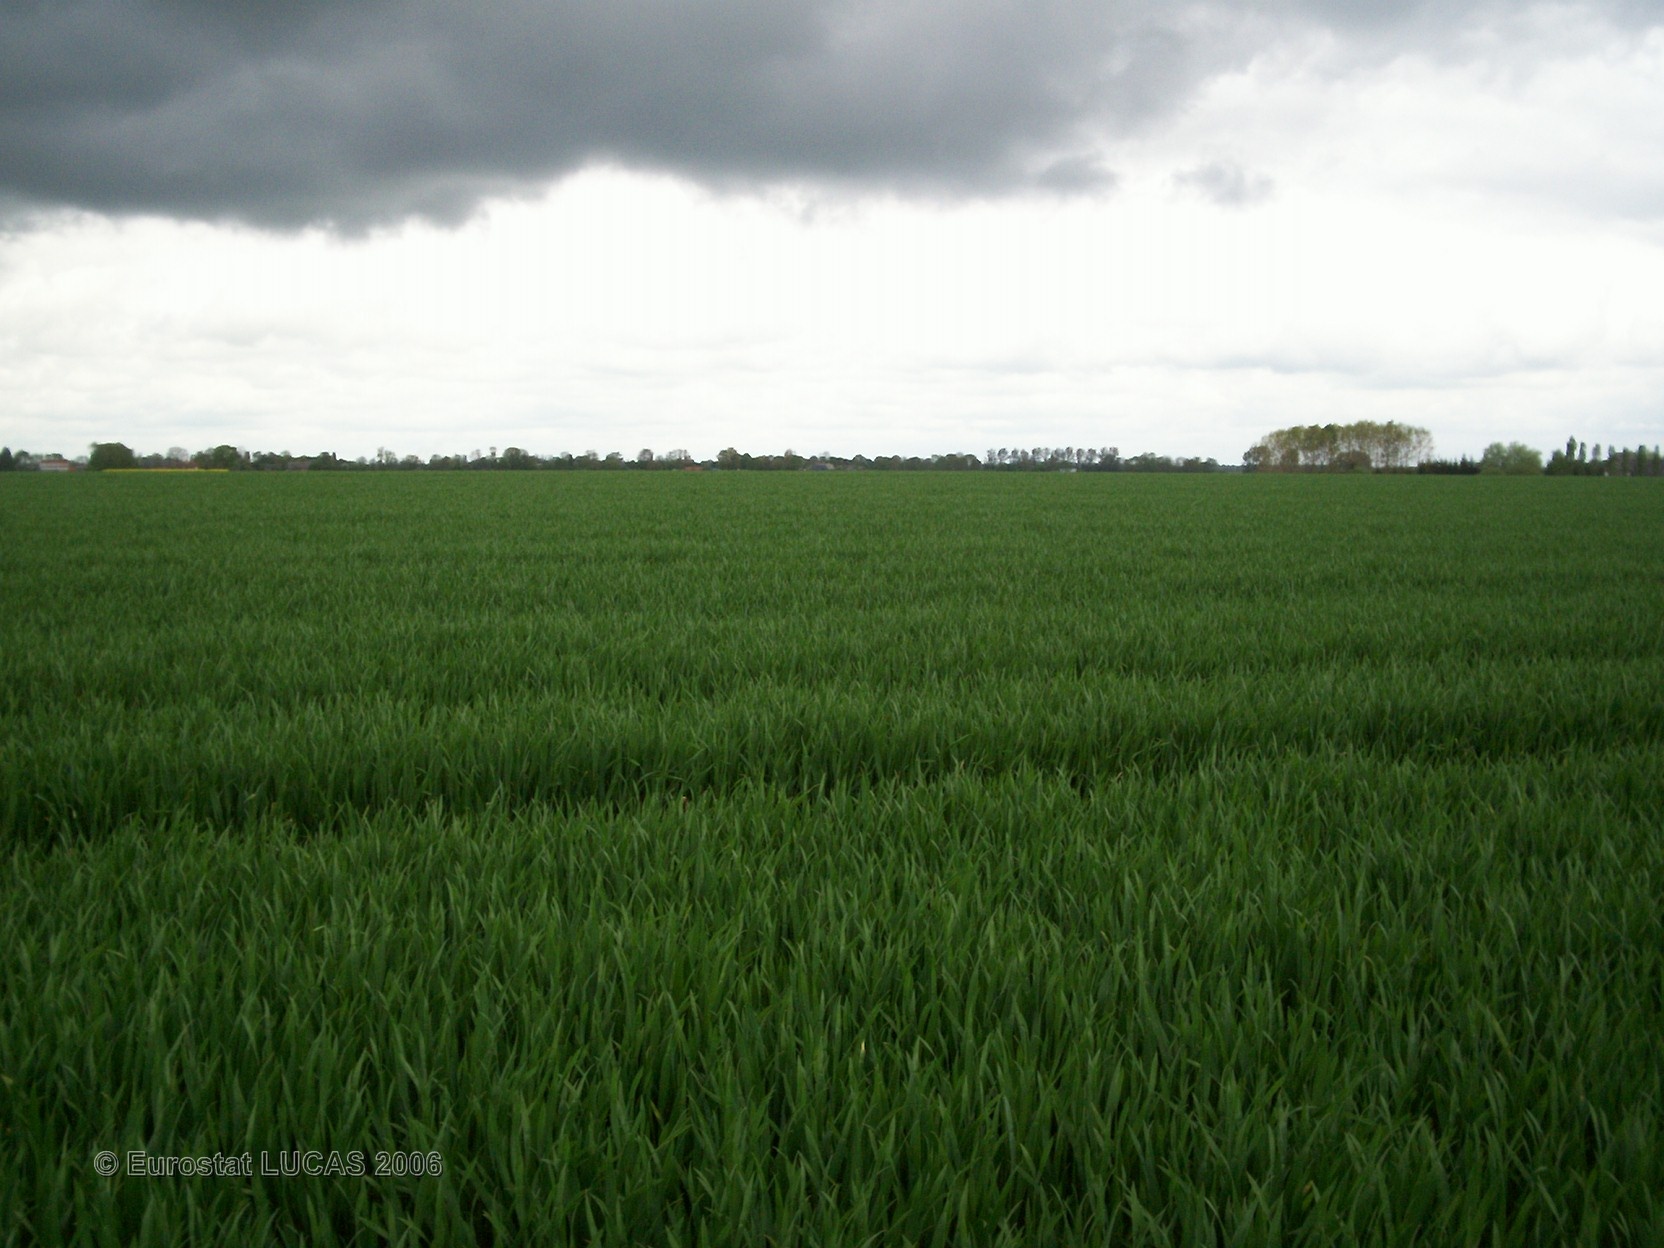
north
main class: Cropland
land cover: Common wheat
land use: Agriculture (excluding fallow land and kitchen gardens)
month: May
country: FR
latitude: 49.0460
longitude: 0.5203
